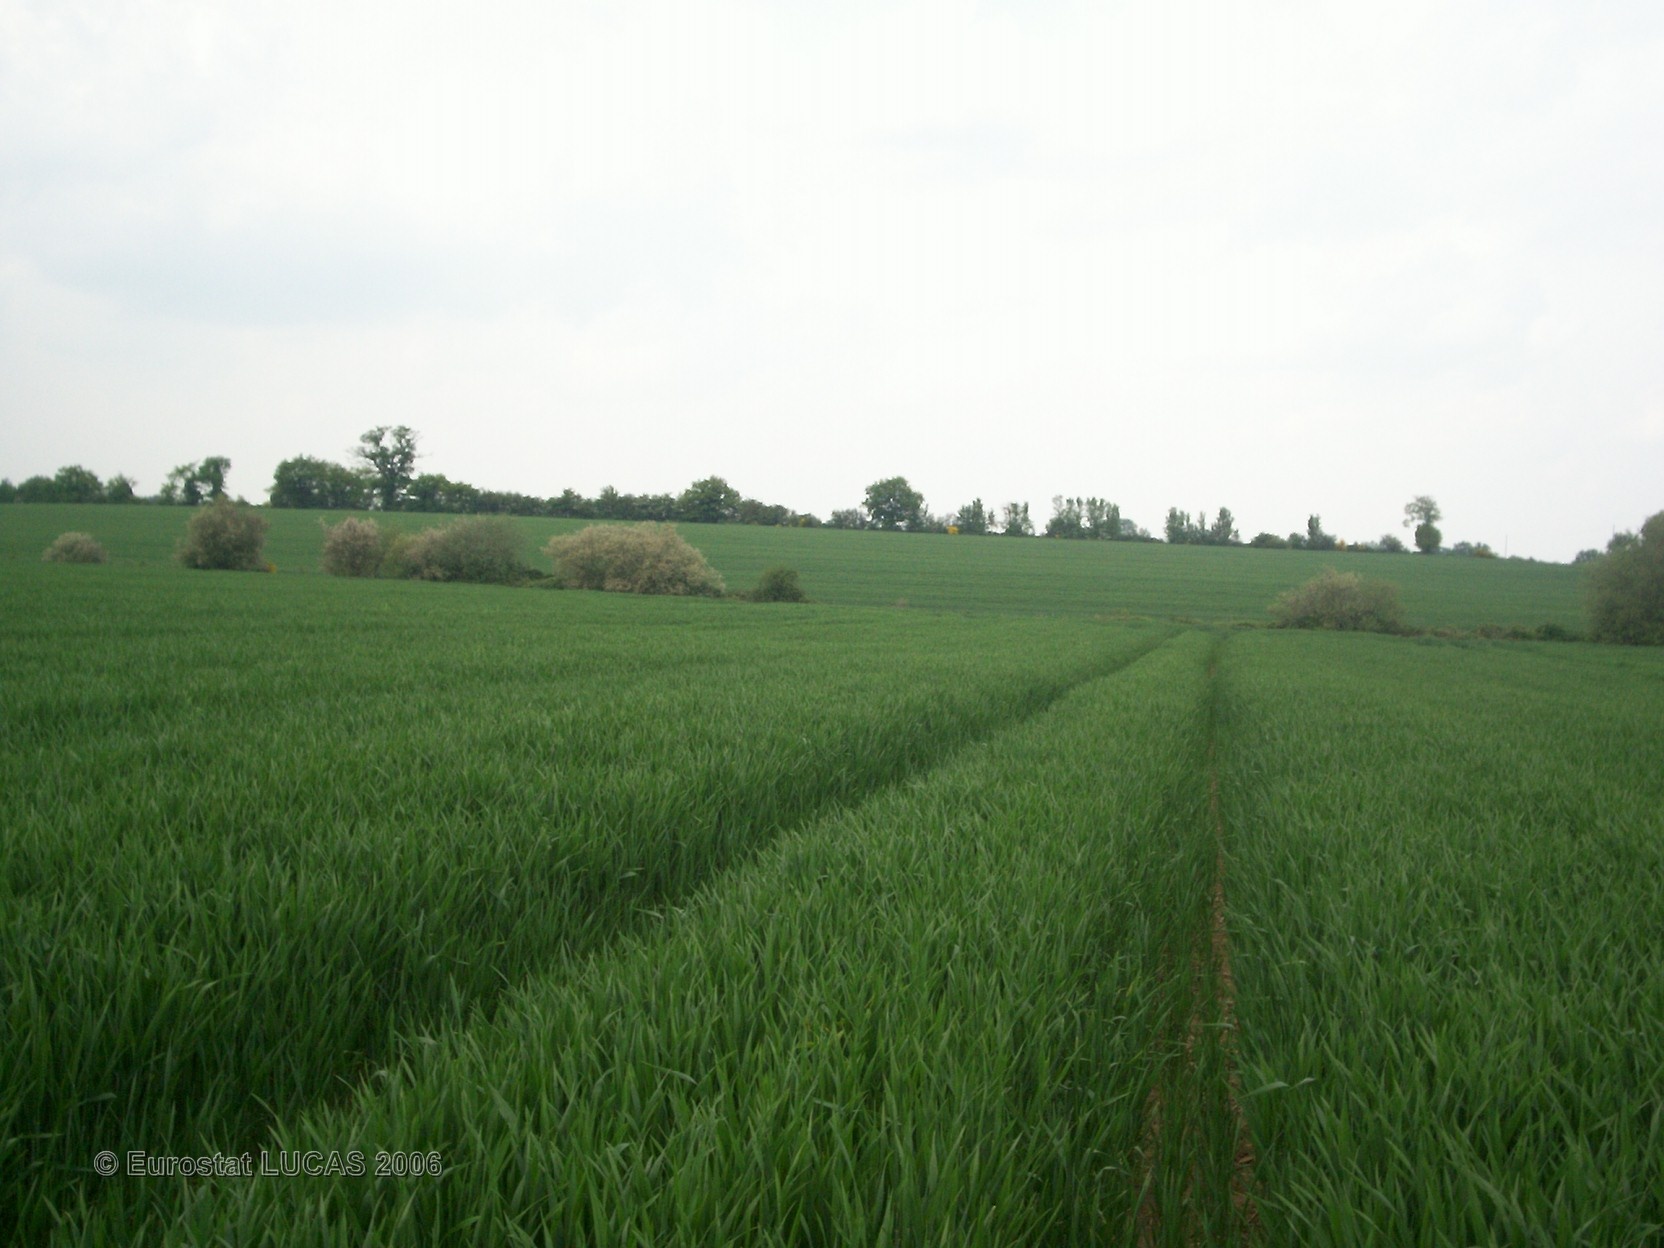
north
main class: Cropland
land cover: Common wheat
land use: Agriculture (excluding fallow land and kitchen gardens)
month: May
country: FR
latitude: 47.8404
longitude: -0.5756
